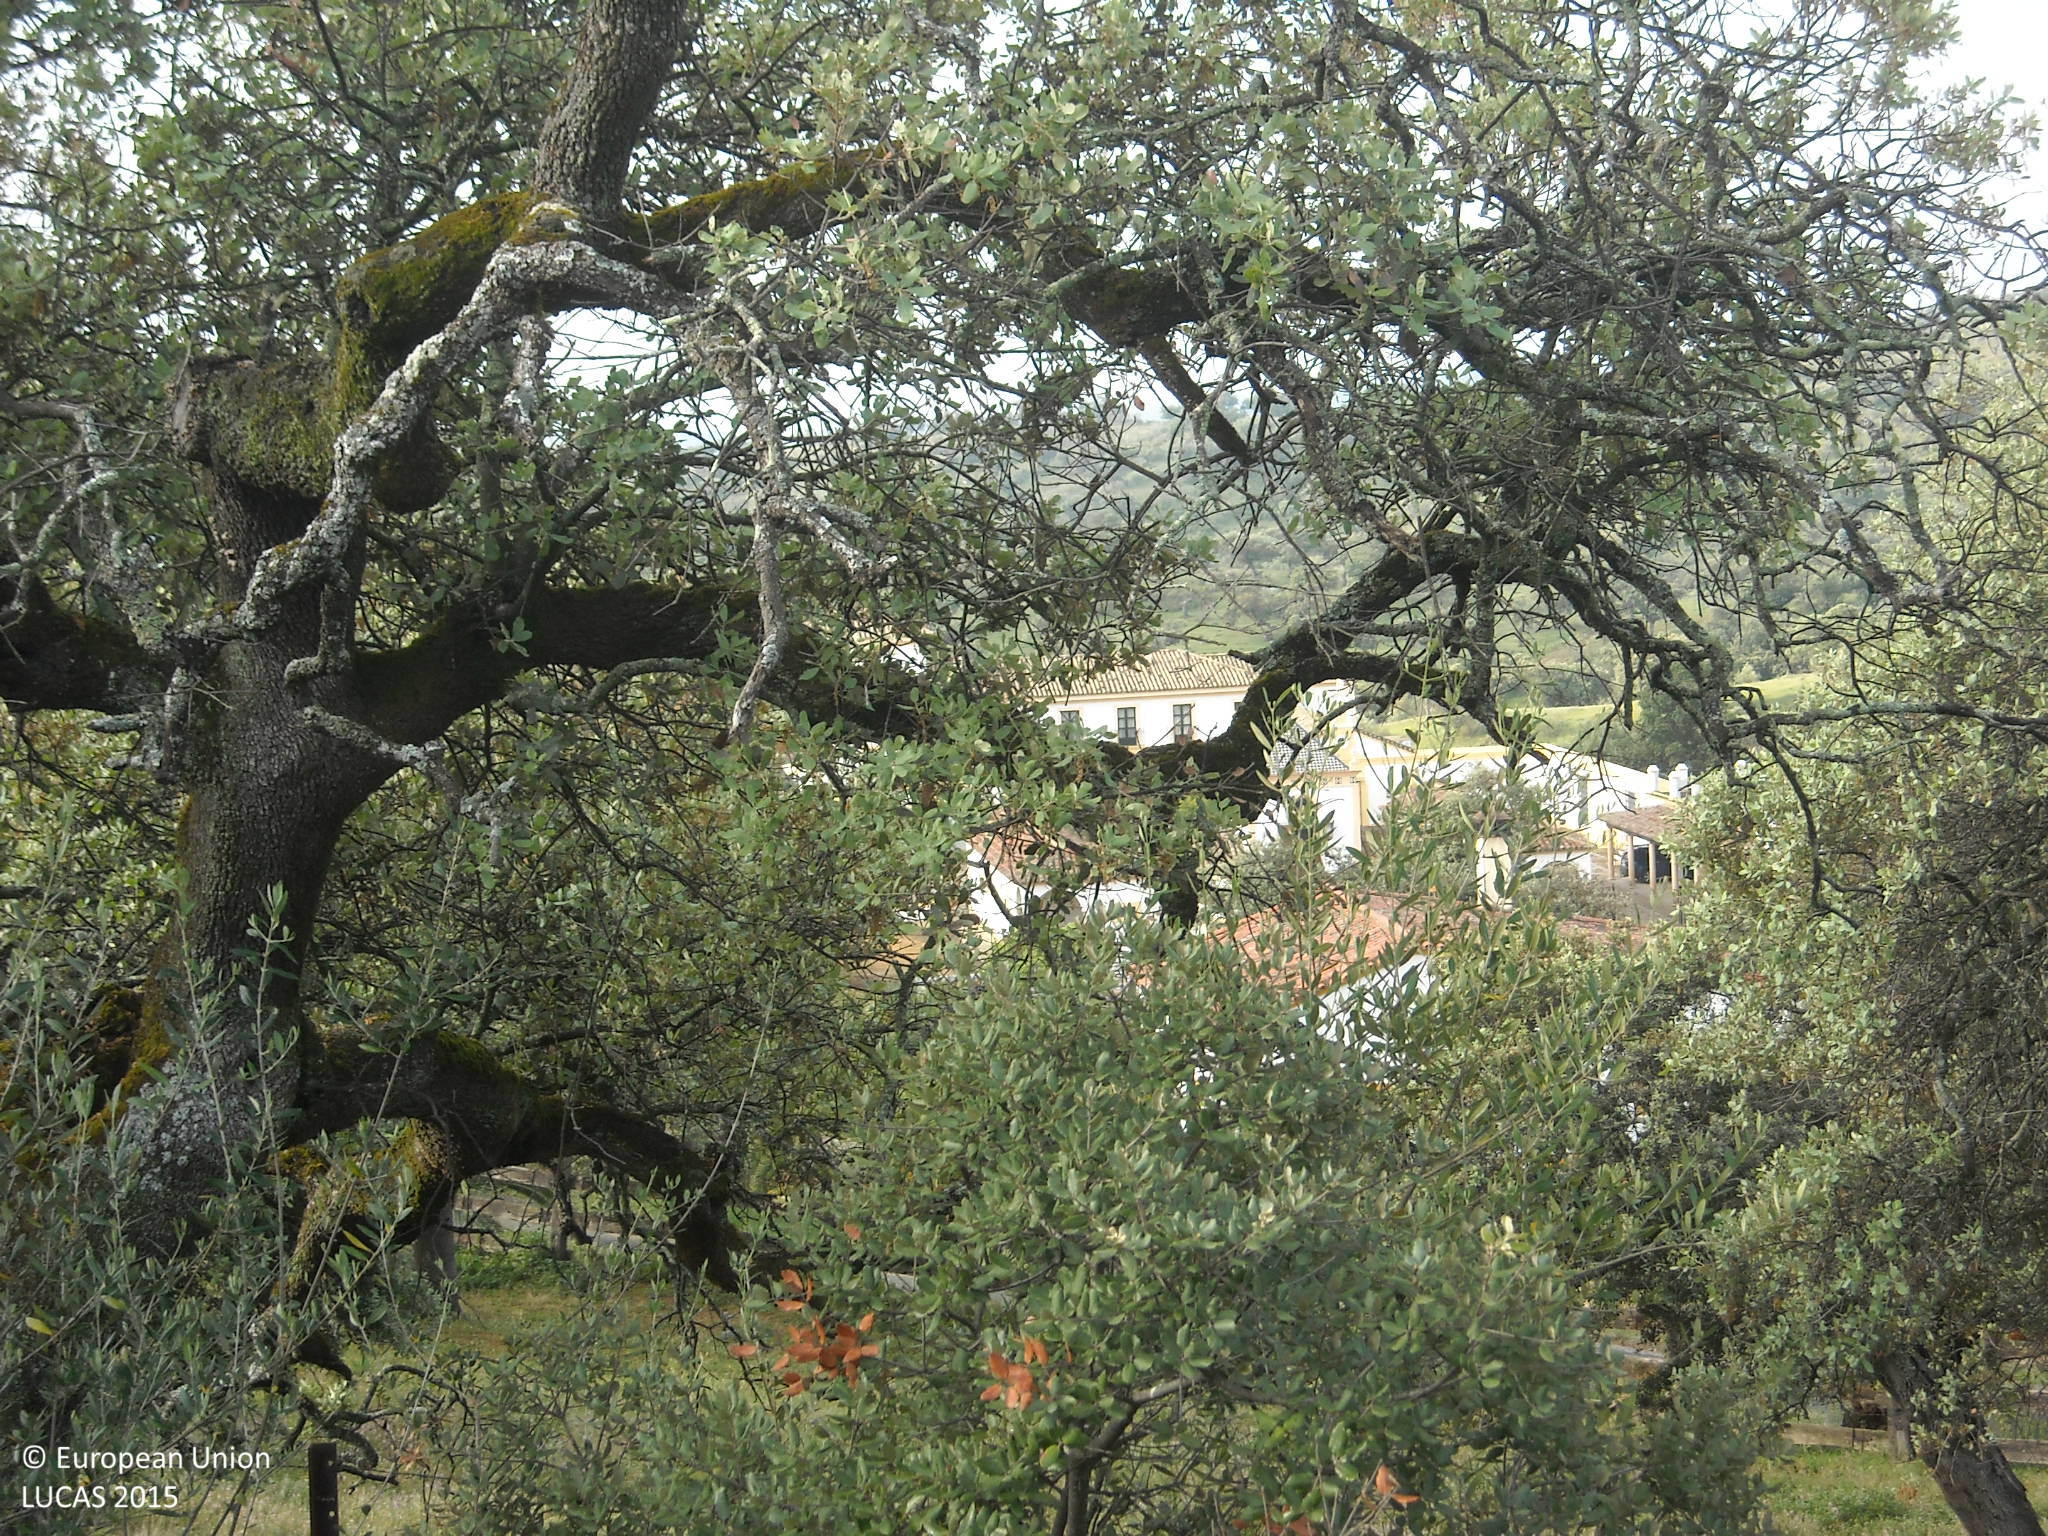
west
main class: Woodland
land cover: Broadleaved woodland
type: broadleaved evergreen forest
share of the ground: 10 - 25 %
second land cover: Grassland without tree/shrub cover
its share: > 75 %
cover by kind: herbaceous plants 70 %, broadleaved forest trees 20 %, shrubs 10 %
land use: Forestry
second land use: Agriculture (excluding fallow land and kitchen gardens)
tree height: > 5 m
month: April
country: ES
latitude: 37.7059
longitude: -6.2428
